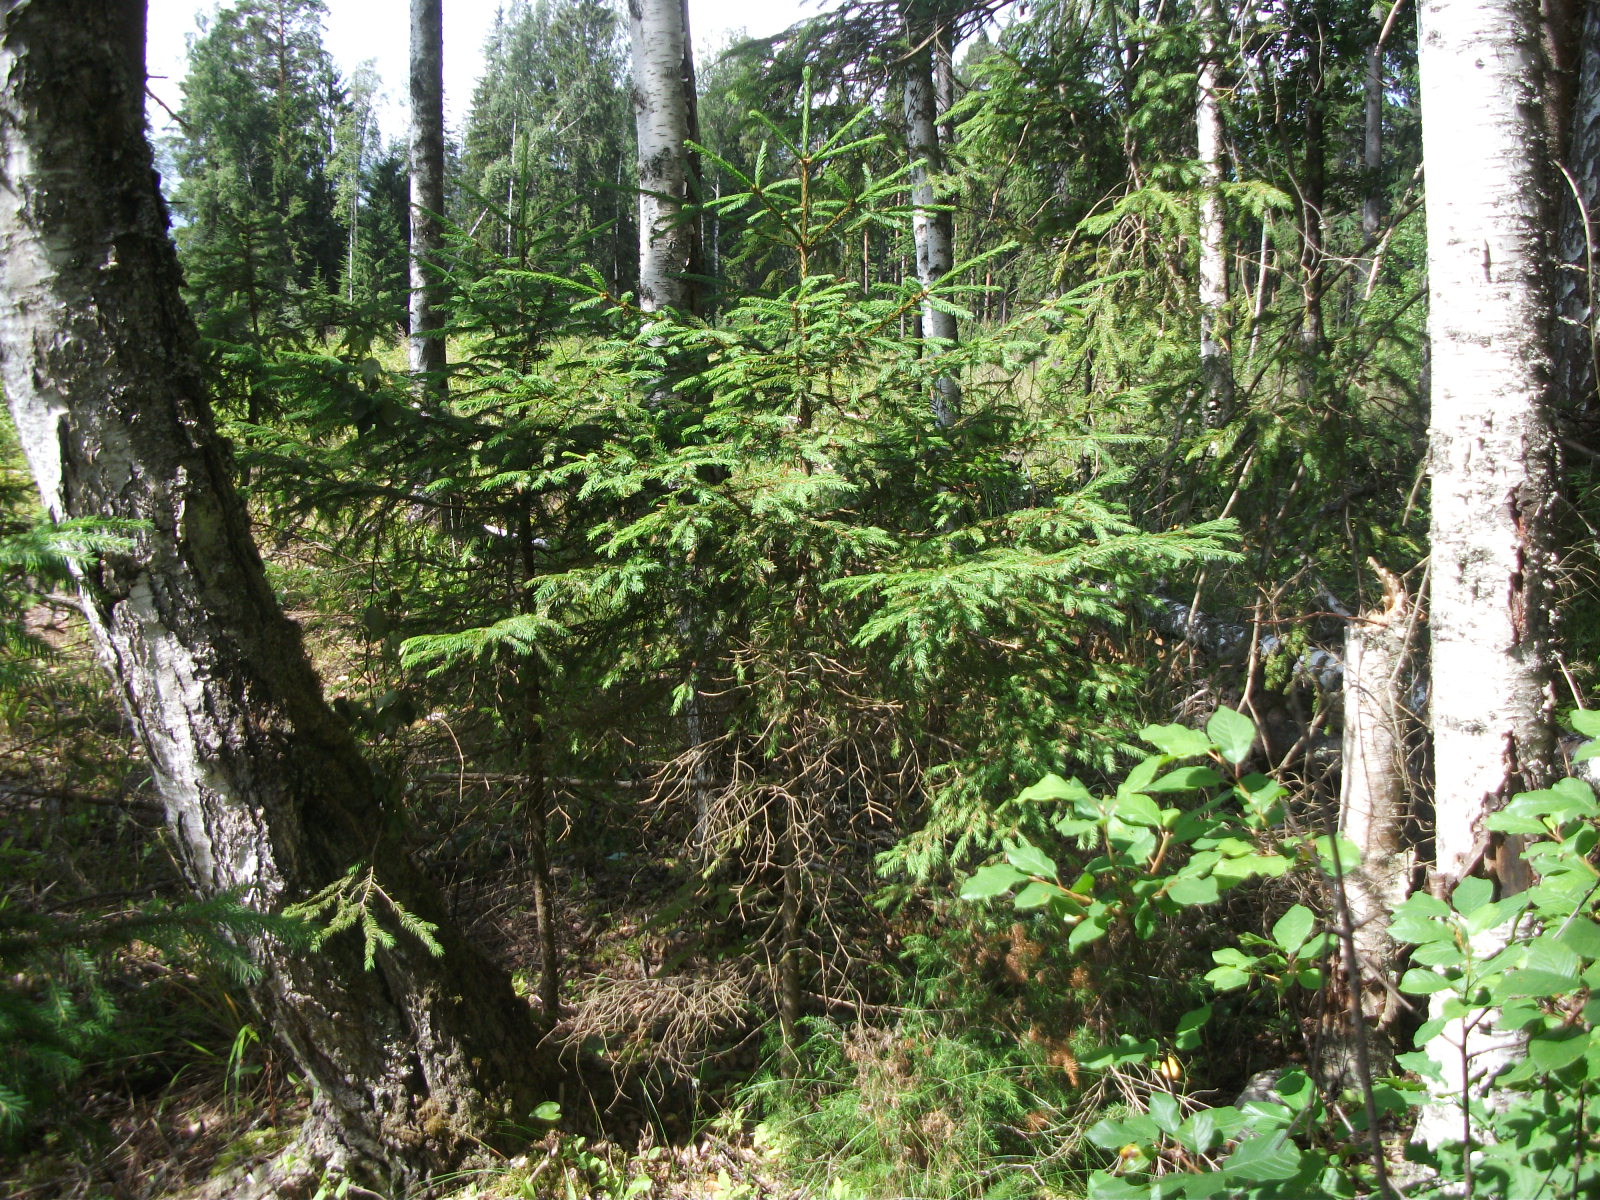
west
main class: Woodland
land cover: Spruce dominated mixed woodland
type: hemiboreal forest and nemoral coniferous forest and mixed broadleaved-coniferous forest
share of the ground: > 75 %
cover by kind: coniferous forest trees 65 %, broadleaved forest trees 25 %, herbaceous plants 10 %
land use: Forestry
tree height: > 5 m
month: July
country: LV
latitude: 57.0684
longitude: 26.2854
